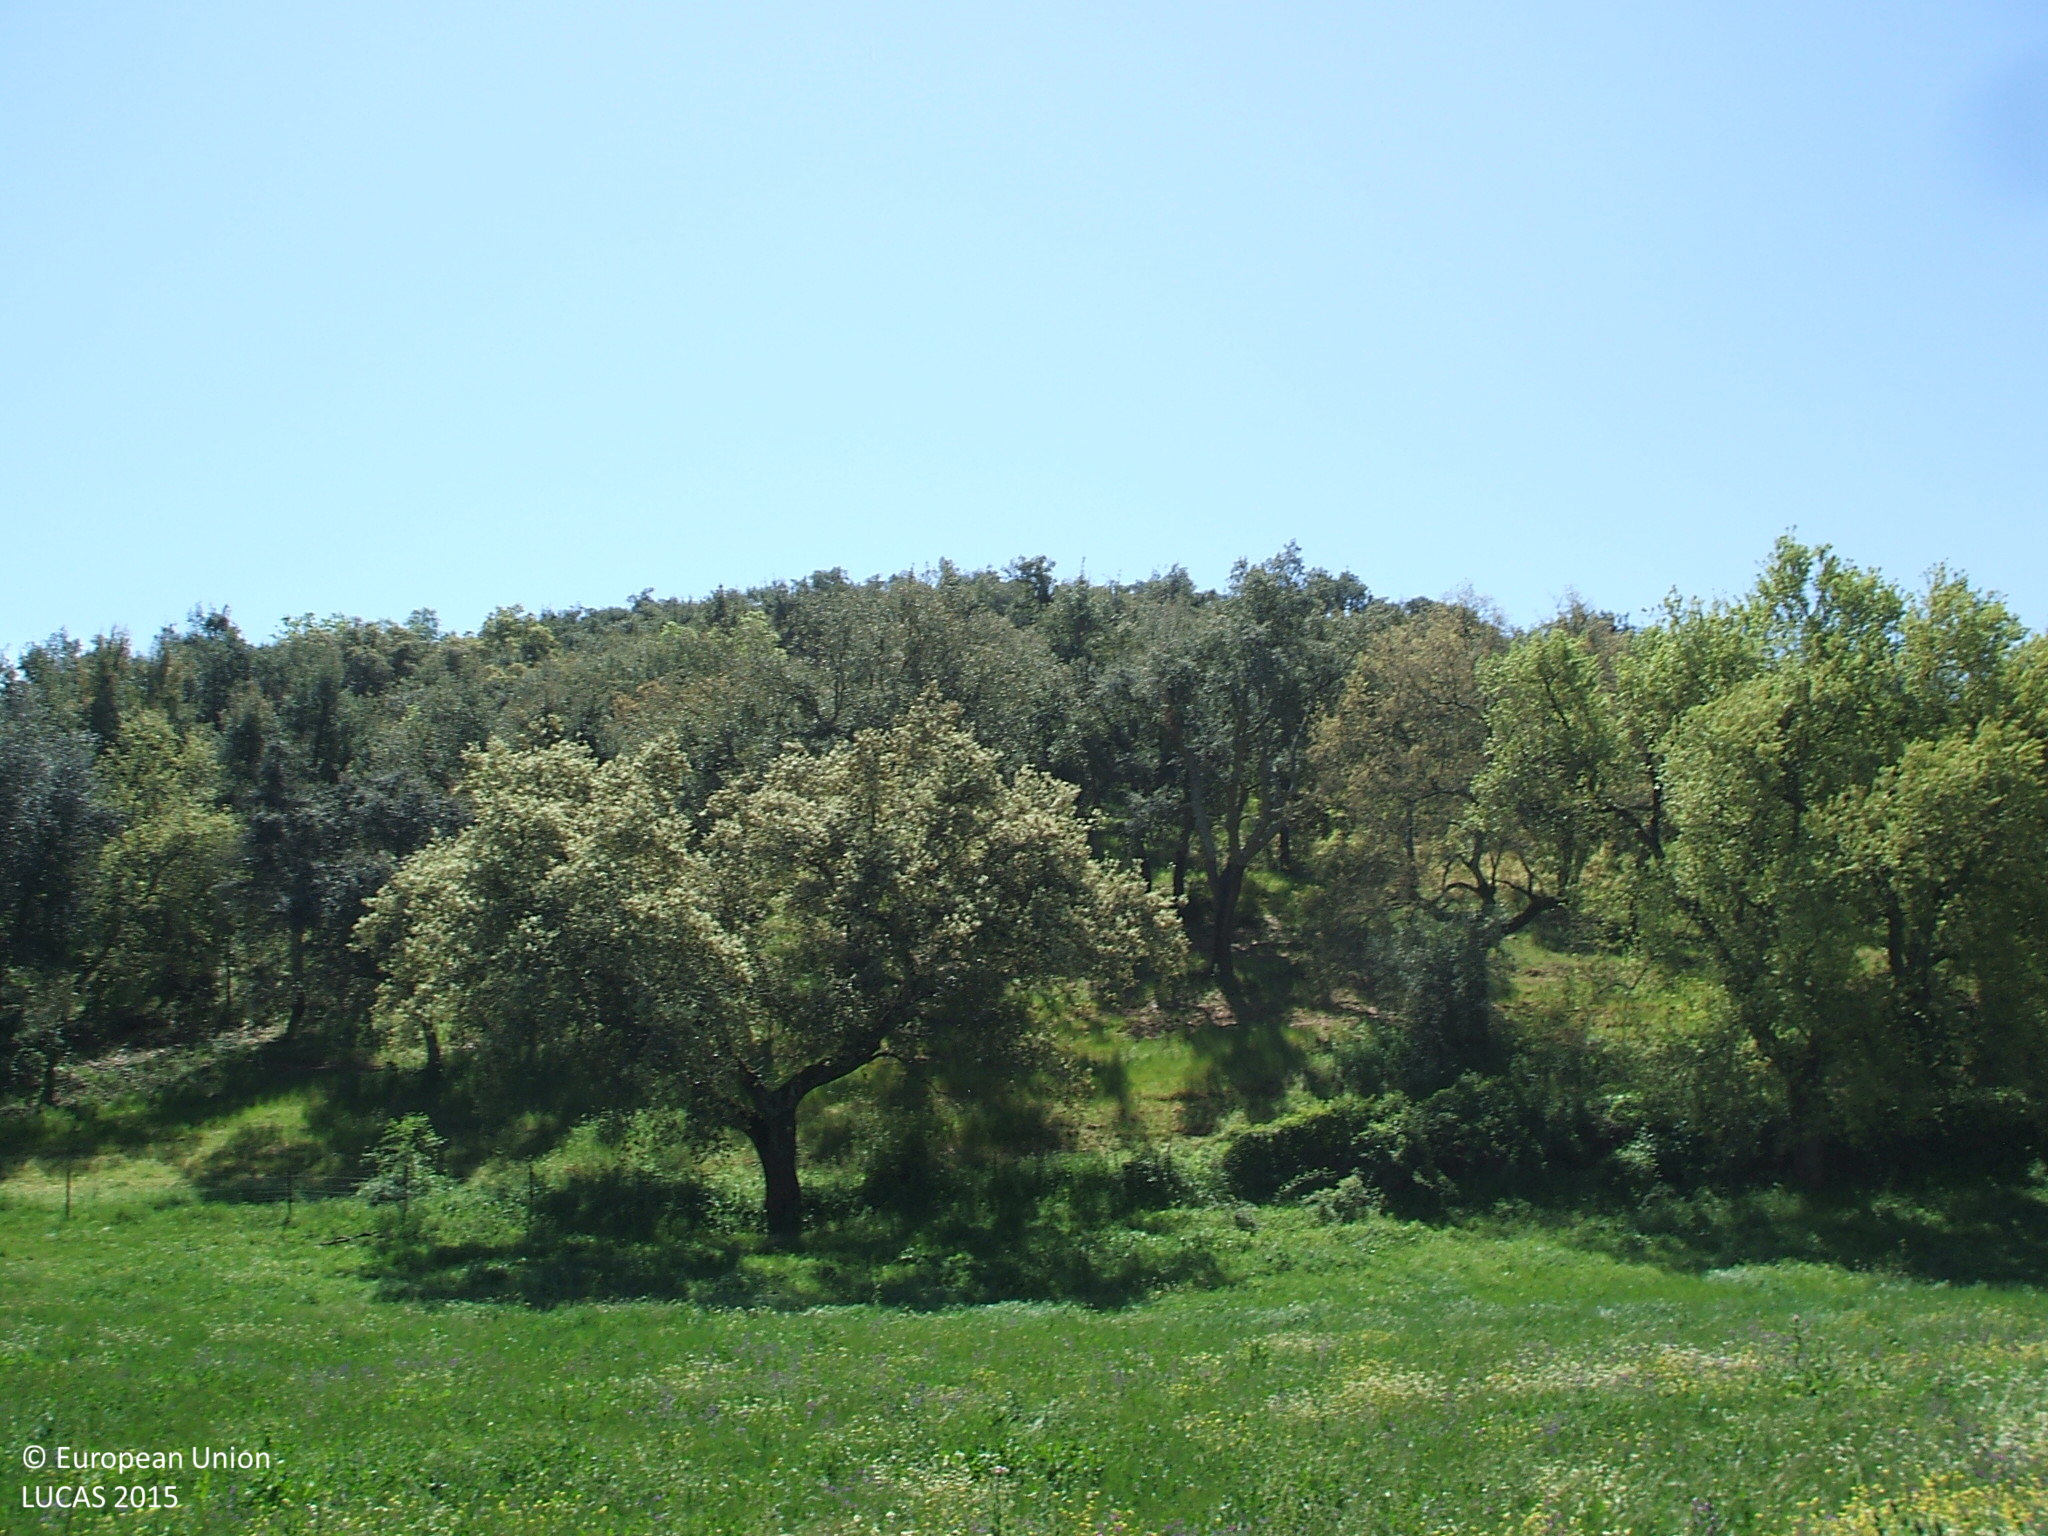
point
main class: Woodland
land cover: Broadleaved woodland
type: broadleaved evergreen forest
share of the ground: 50 - 75 %
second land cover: Grassland without tree/shrub cover
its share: > 75 %
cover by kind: broadleaved forest trees 50 %, herbaceous plants 50 %
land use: Forestry
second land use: Agriculture (excluding fallow land and kitchen gardens)
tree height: > 5 m
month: April
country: ES
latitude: 37.8961
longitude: -5.6641
